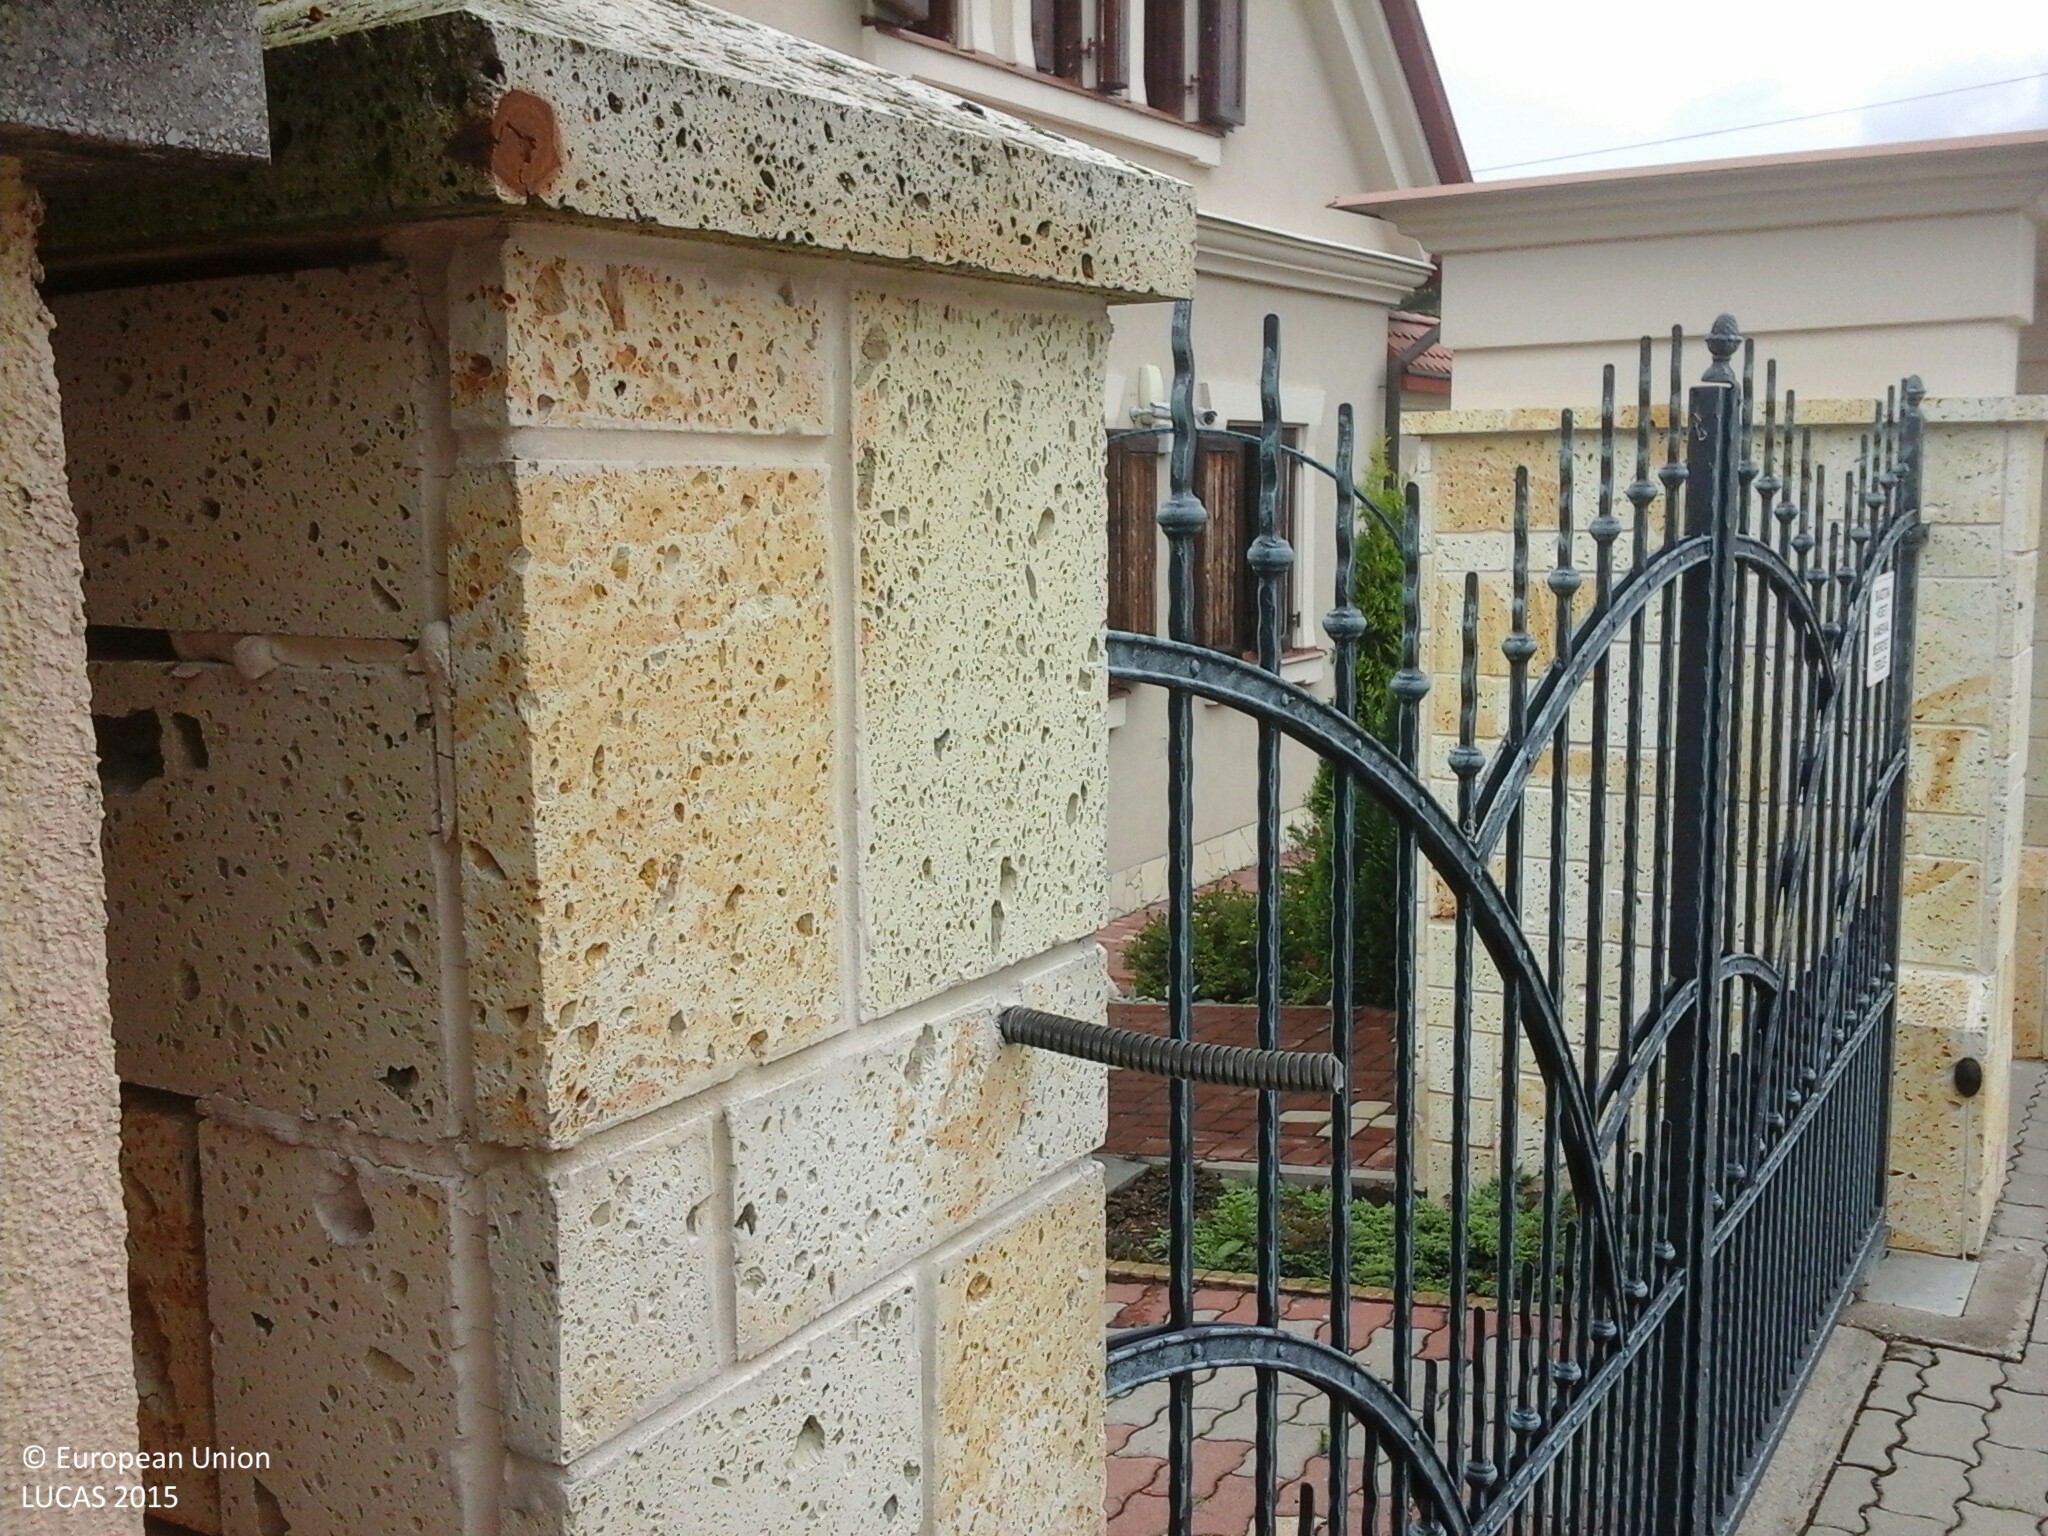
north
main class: Grassland
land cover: Grassland with sparse tree/shrub cover
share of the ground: > 75 %
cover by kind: herbaceous plants 85 %, shrubs 10 %, broadleaved forest trees 5 %
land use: Residential
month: July
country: HU
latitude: 47.9650
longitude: 20.4120
